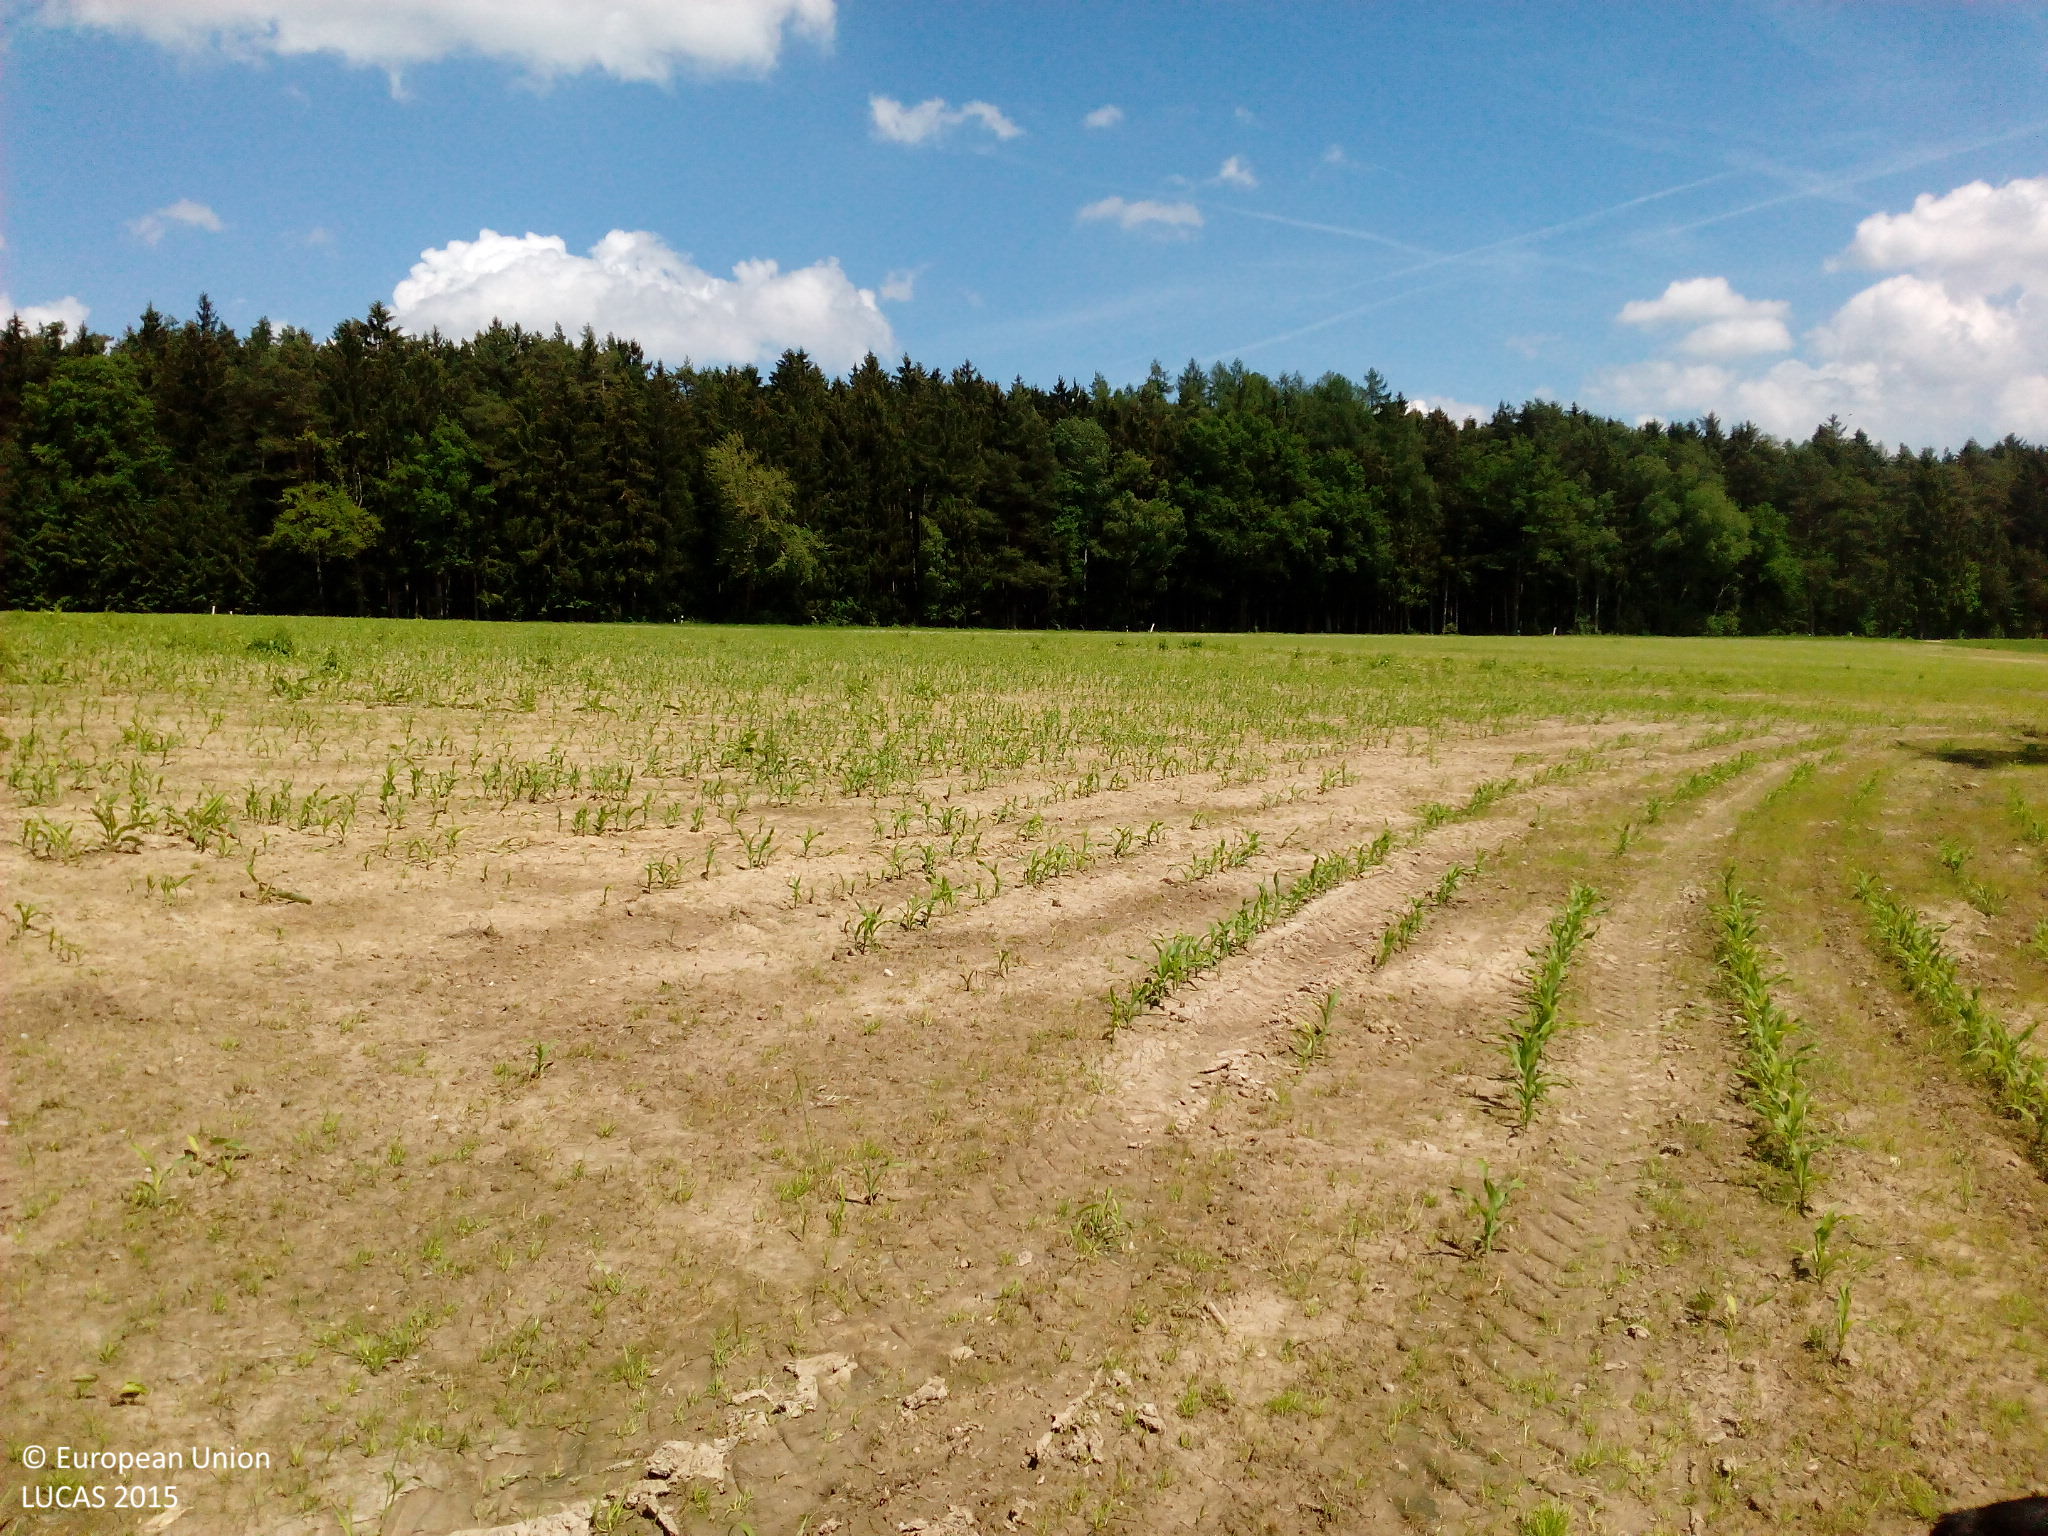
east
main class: Cropland
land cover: Maize
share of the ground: < 10 %
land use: Agriculture (excluding fallow land and kitchen gardens)
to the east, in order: Maize; Grass margins; Spruce dominated coniferous woodland; Tracks; Pine dominated coniferous woodland
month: June
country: DE
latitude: 48.5216
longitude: 12.3956
